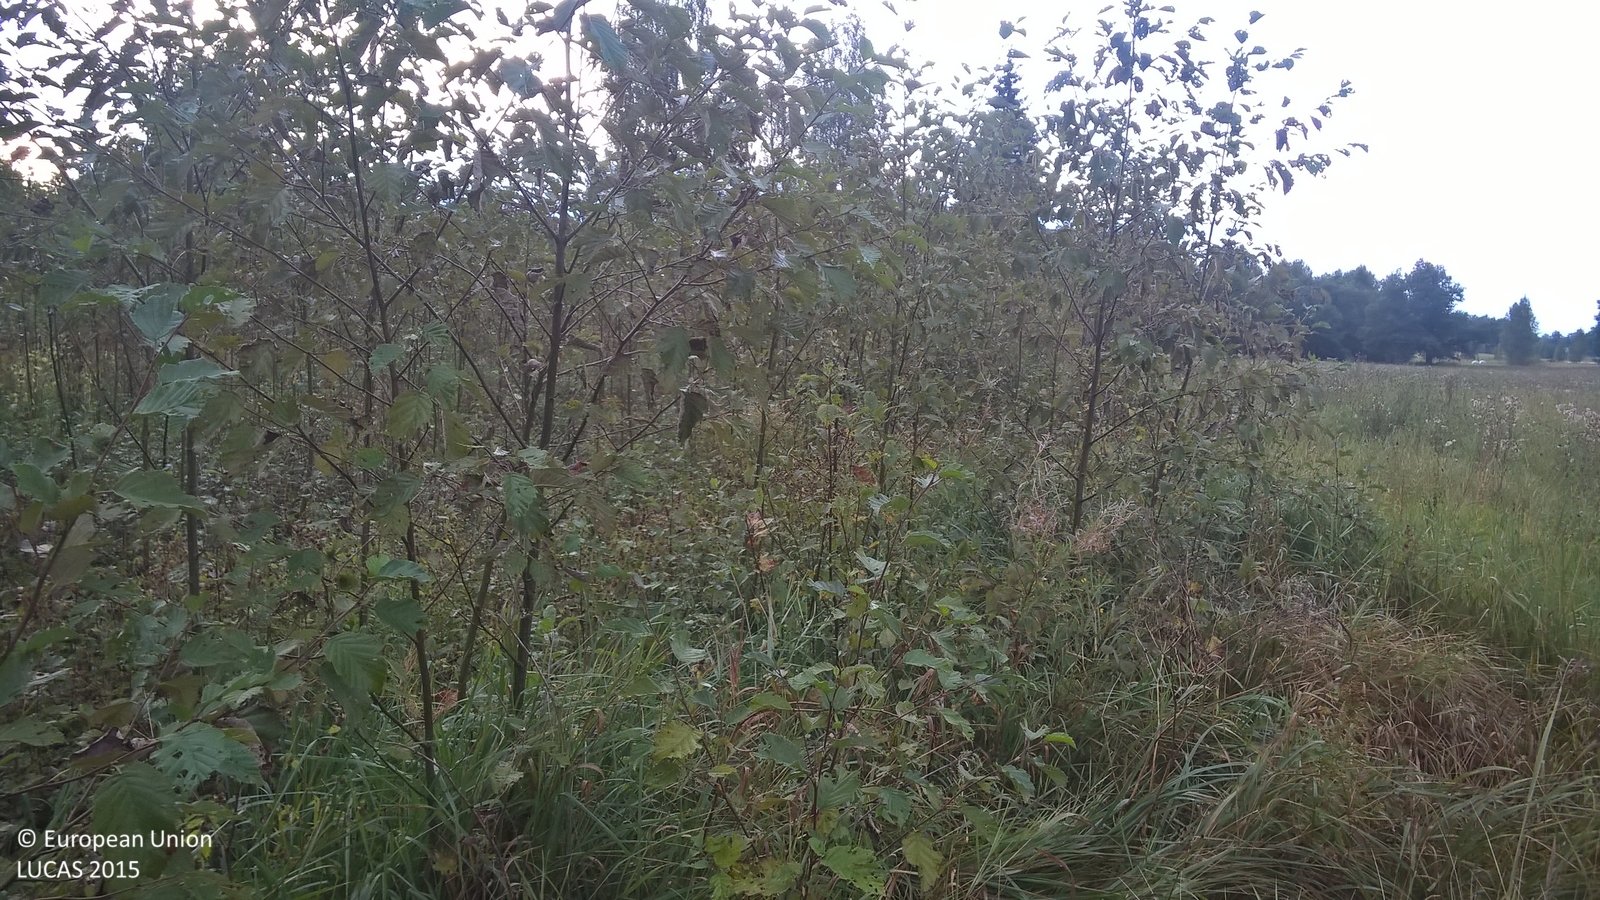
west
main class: Woodland
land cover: Broadleaved woodland
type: non-riverine alder, birch or aspen forest
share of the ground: 50 - 75 %
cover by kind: broadleaved forest trees 70 %, herbaceous plants 30 %
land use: Forestry
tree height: < 5 m
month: September
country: LV
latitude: 57.3676
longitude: 25.4957
